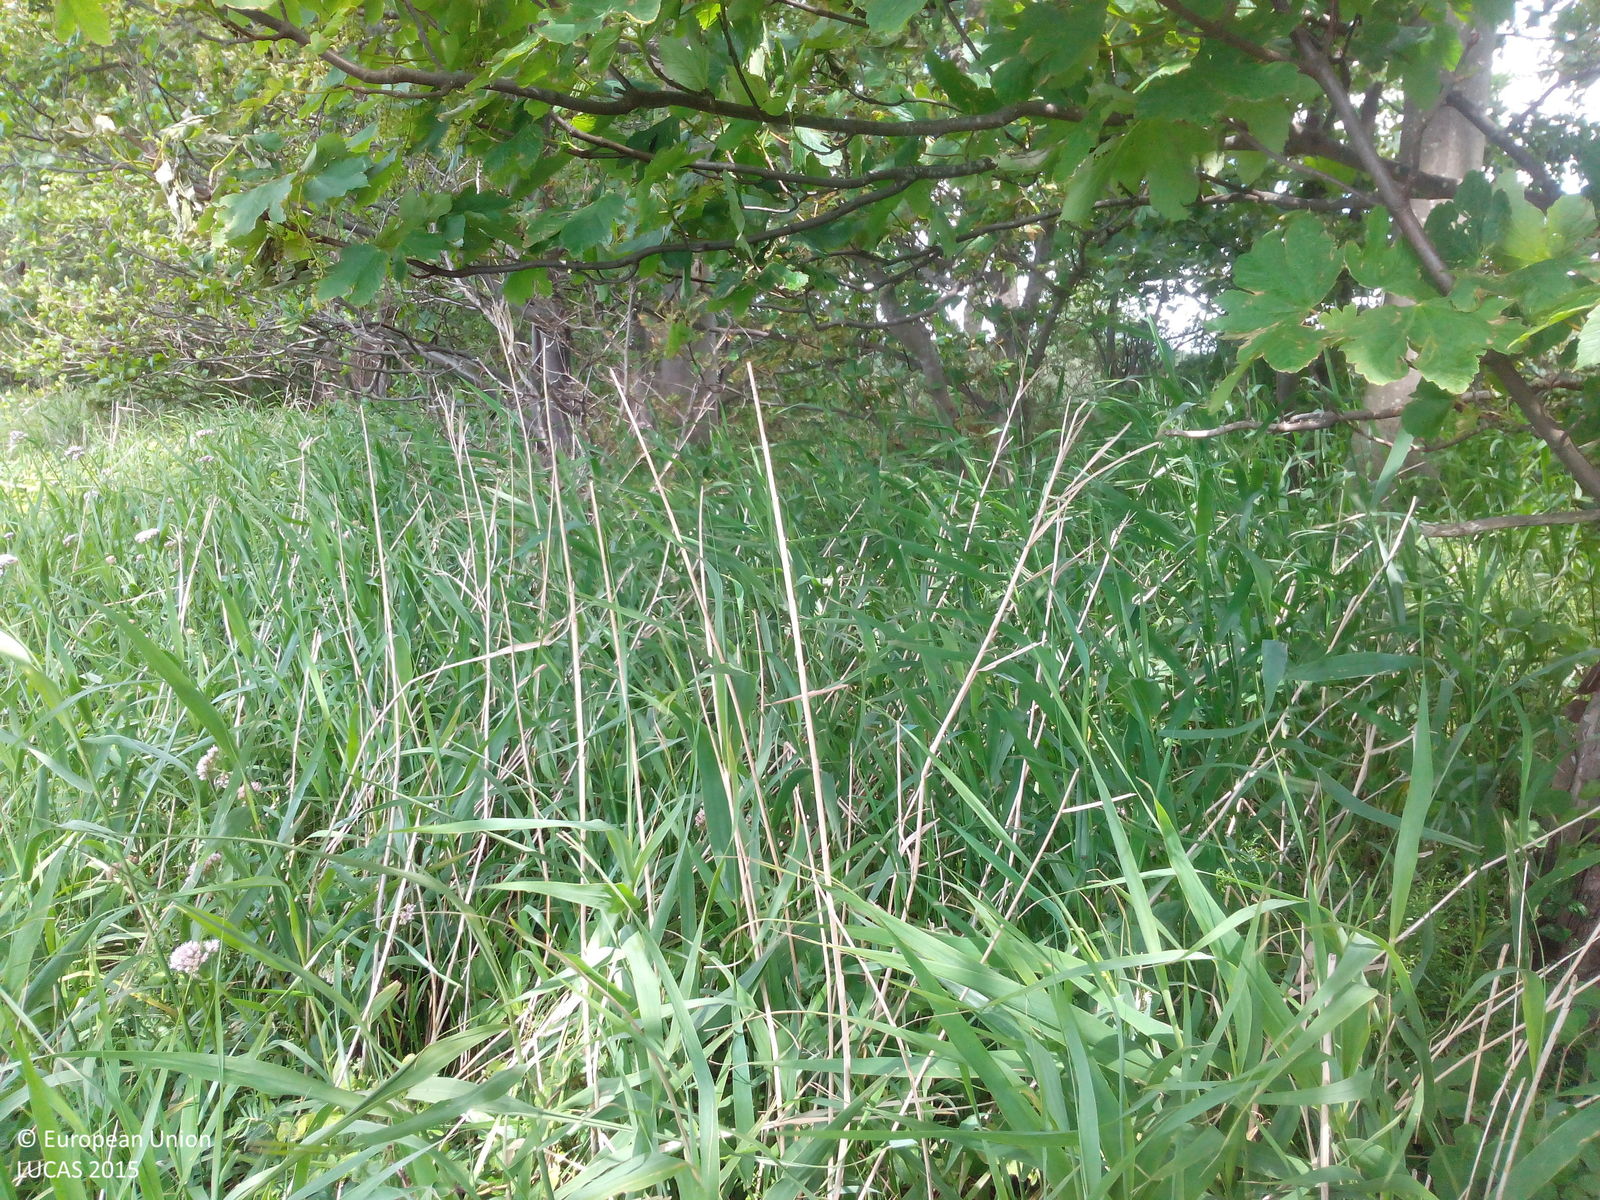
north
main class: Cropland
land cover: Arable land (only in case pi)
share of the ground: > 75 %
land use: Agriculture (excluding fallow land and kitchen gardens)
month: June
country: NL
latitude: 52.7945
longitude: 4.9998
